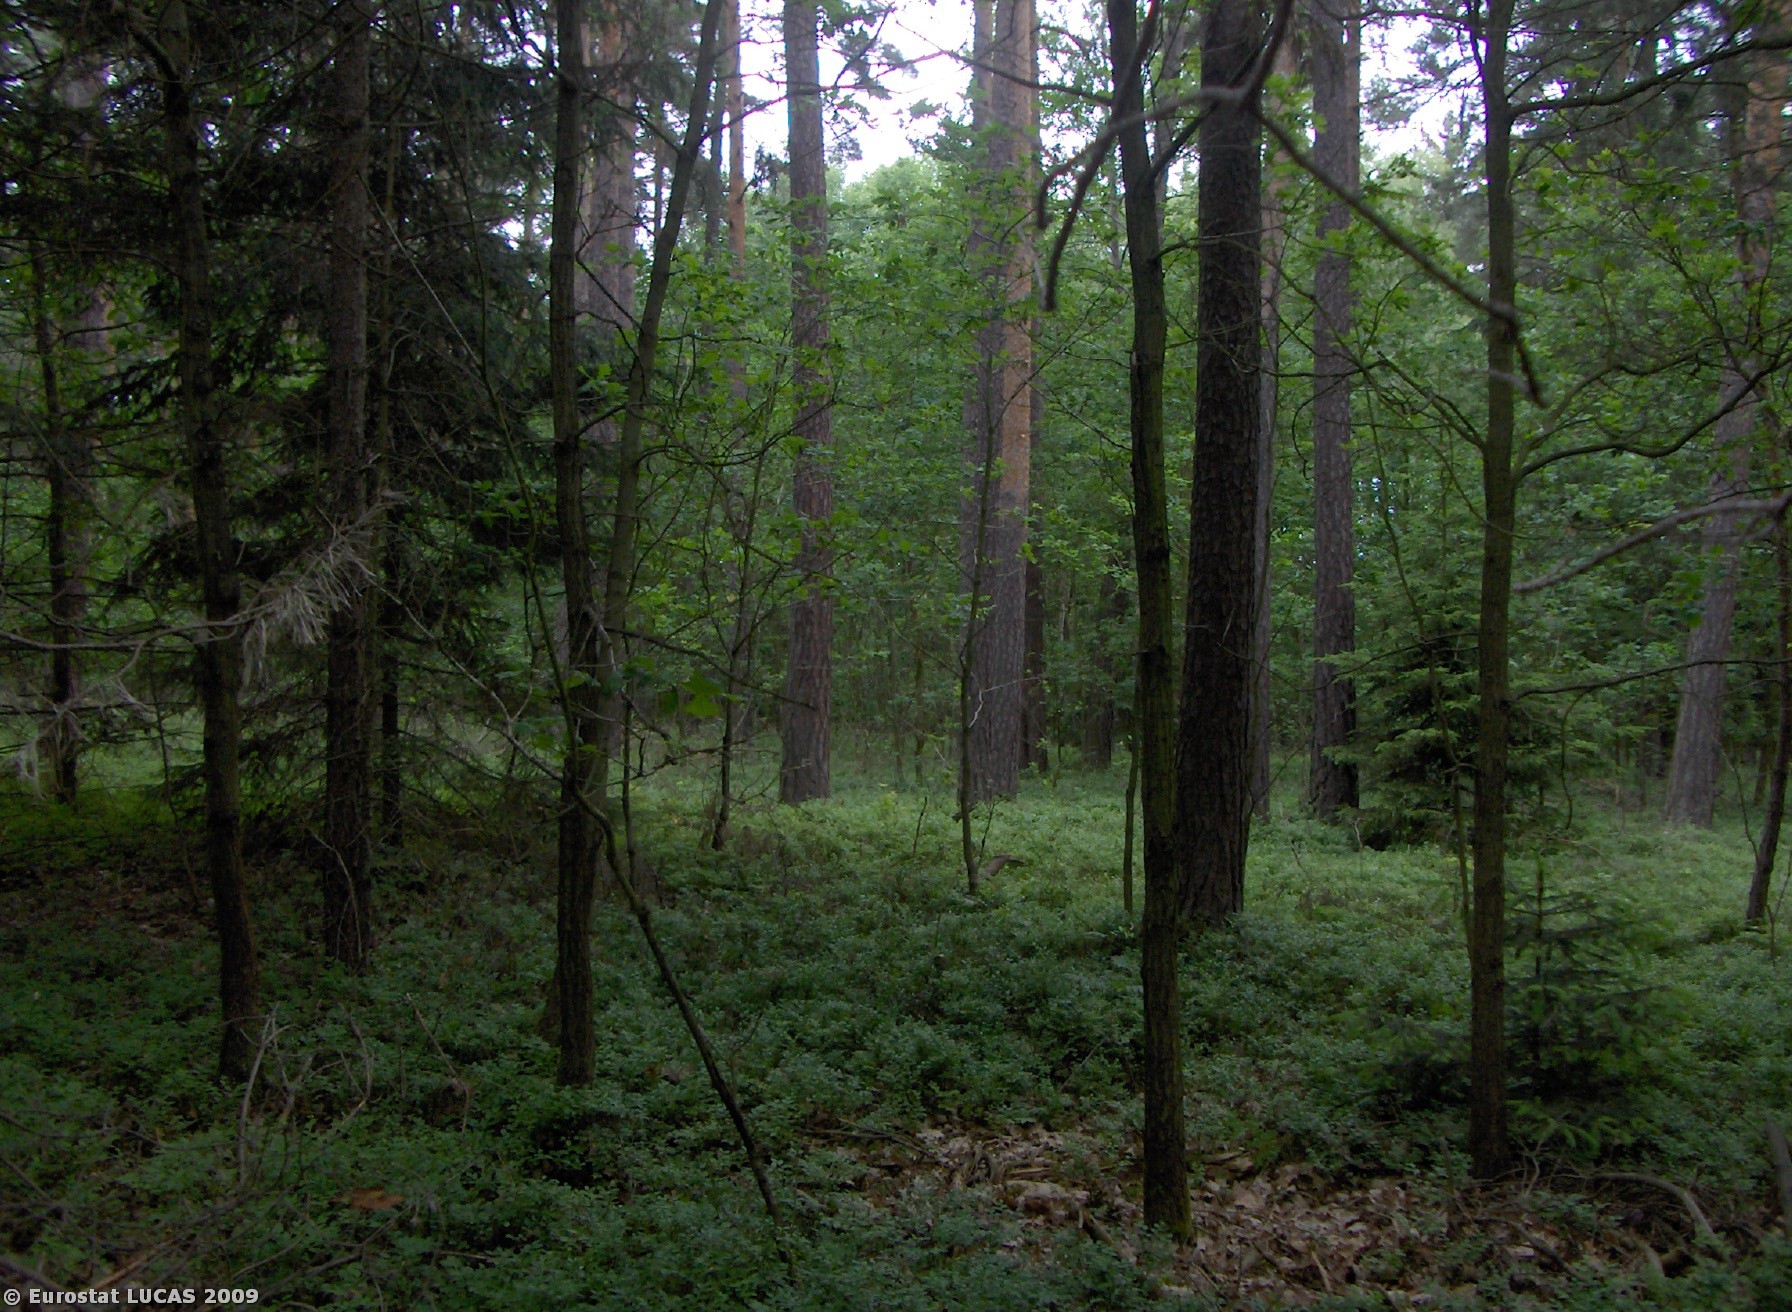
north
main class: Woodland
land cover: Mixed woodland
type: hemiboreal forest and nemoral coniferous forest and mixed broadleaved-coniferous forest
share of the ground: > 75 %
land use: Forestry
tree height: > 5 m
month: June
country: CZ
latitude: 48.9853
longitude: 14.3326
